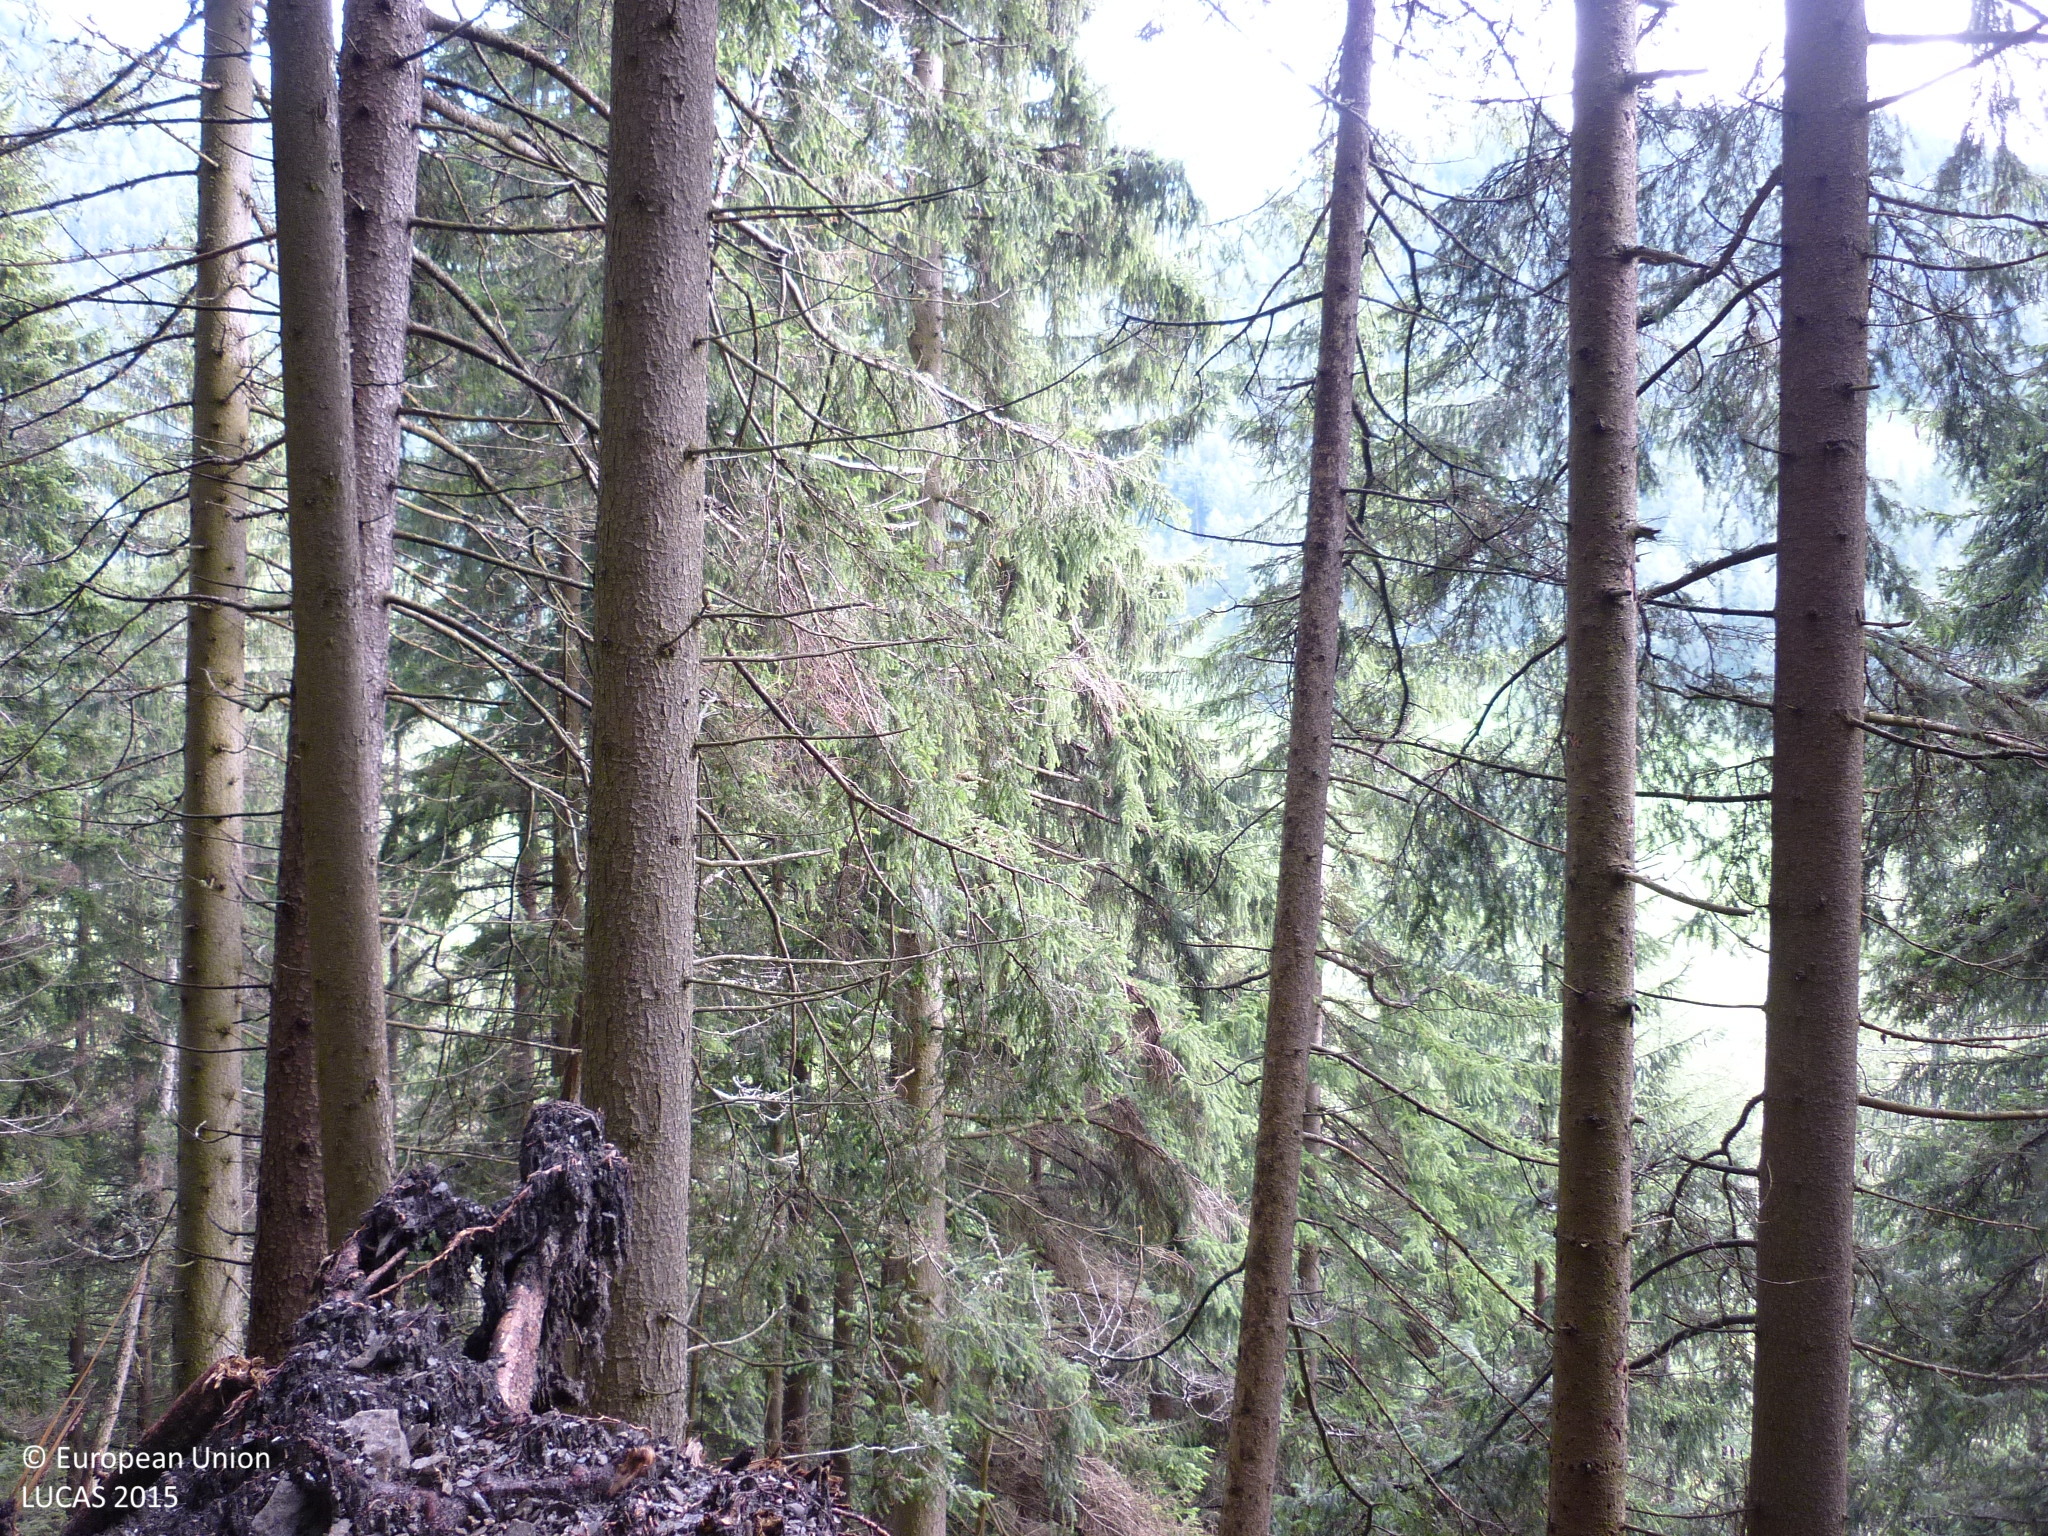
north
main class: Woodland
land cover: Spruce dominated coniferous woodland
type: alpine coniferous forest
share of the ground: > 75 %
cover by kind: coniferous forest trees 90 %, herbaceous plants 10 %
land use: Forestry
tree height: > 5 m
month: August
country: AT
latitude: 47.0300
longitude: 13.5900
